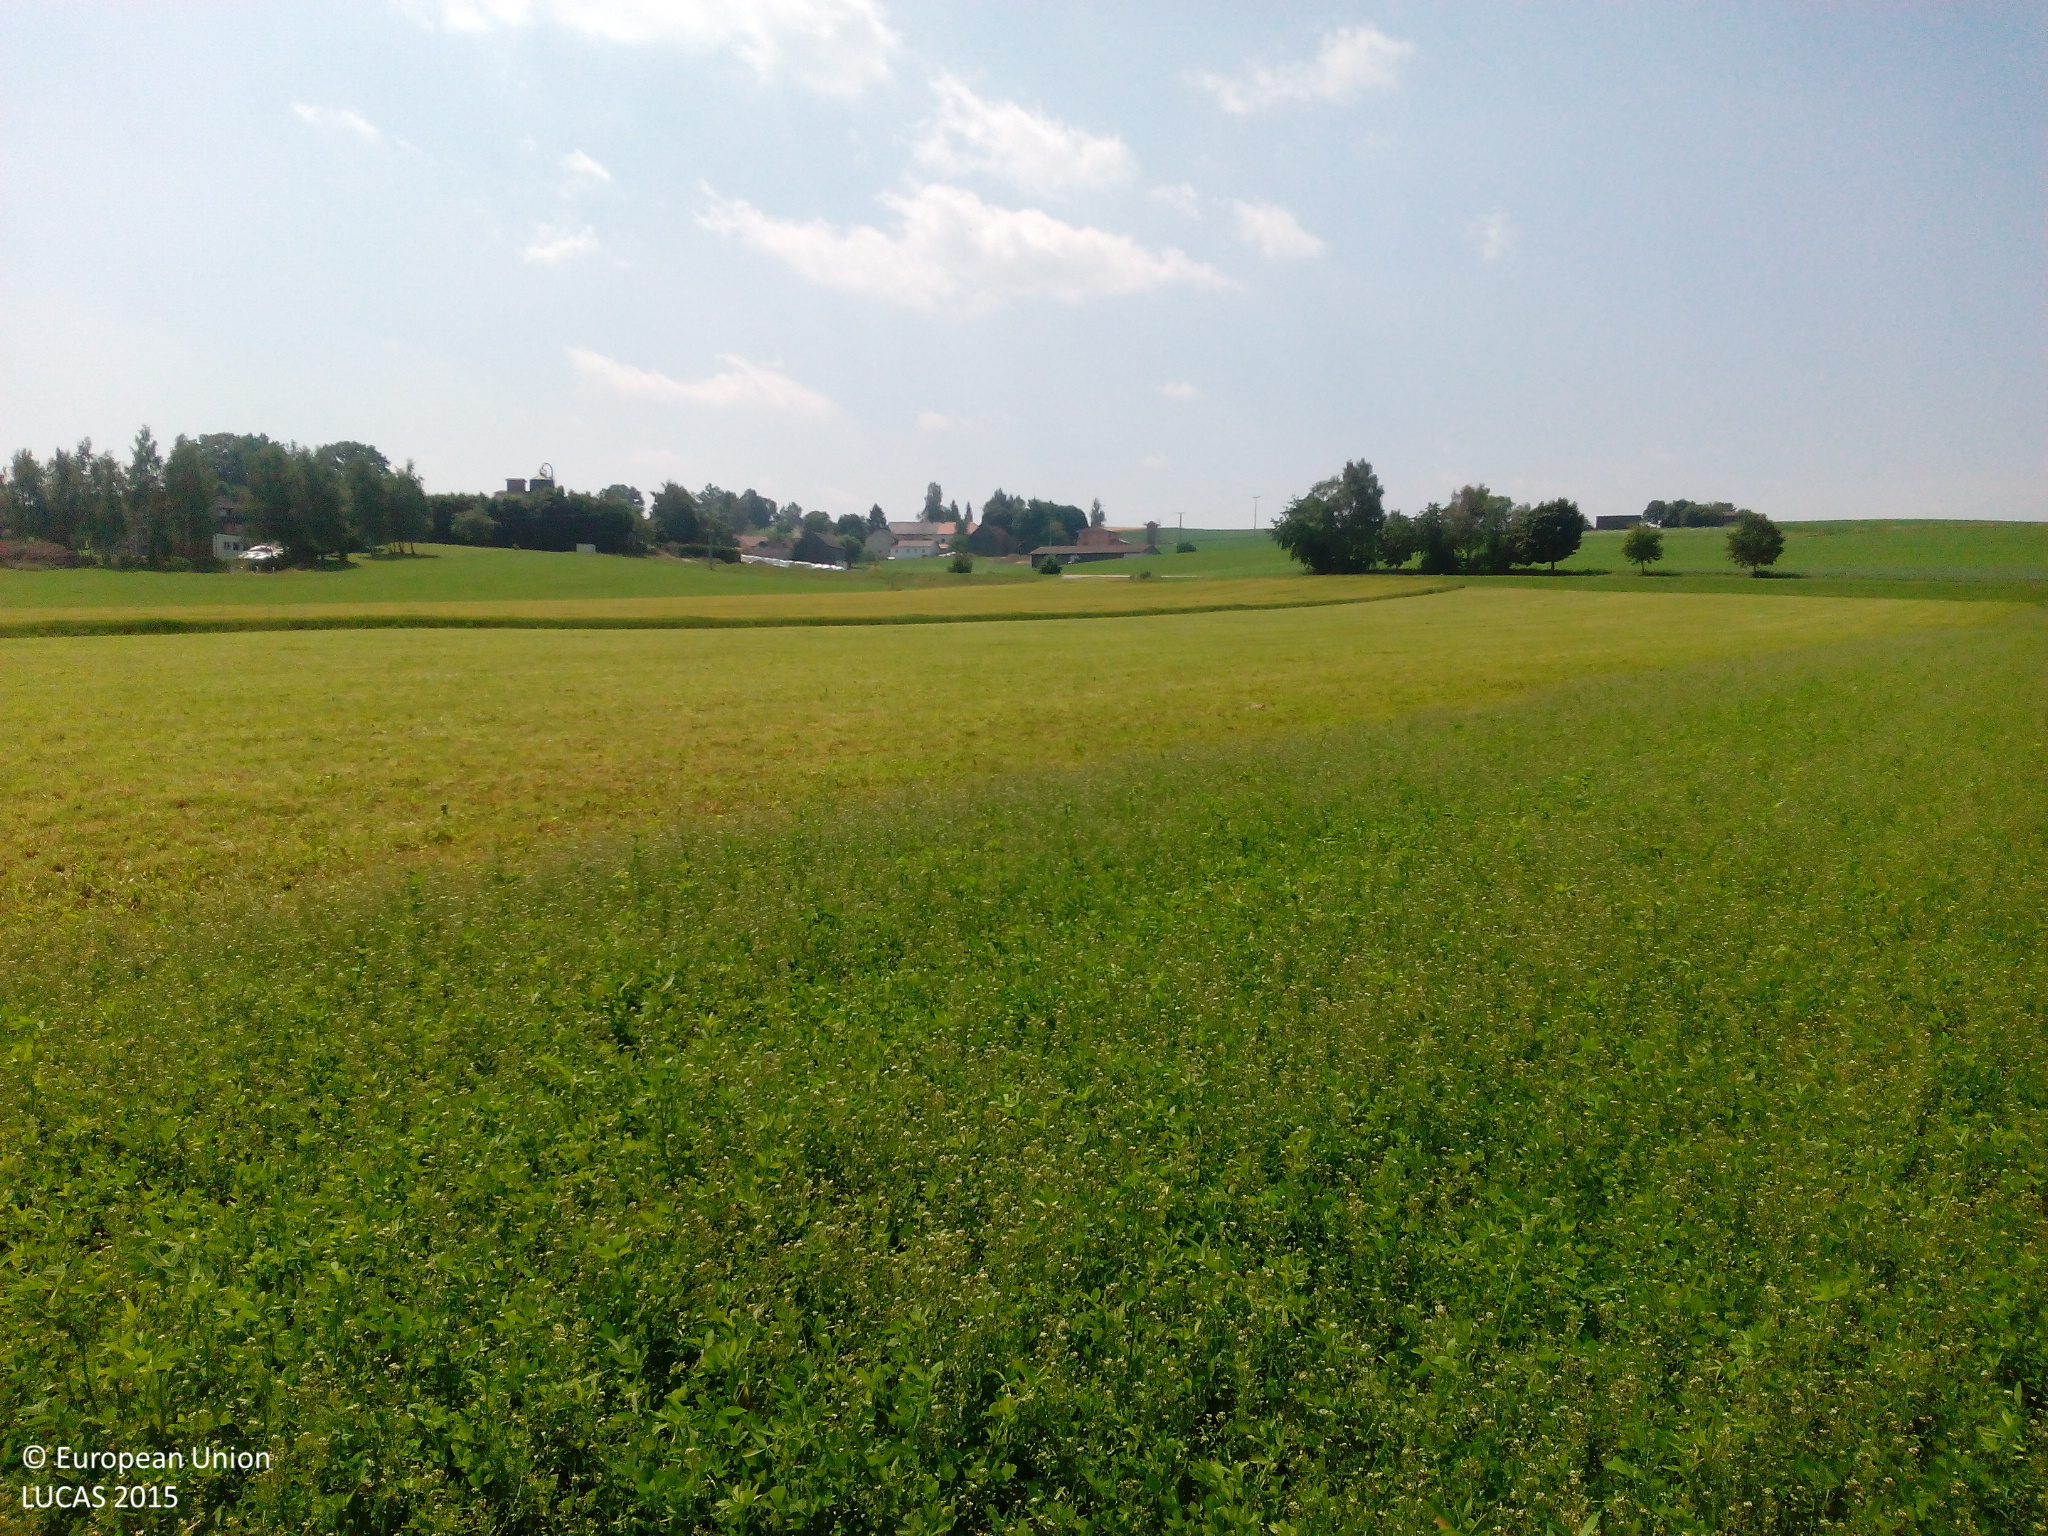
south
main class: Cropland
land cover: Other leguminous and mixtures for fodder
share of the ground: 50 - 75 %
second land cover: Lucerne
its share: 50 - 75 %
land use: Agriculture (excluding fallow land and kitchen gardens)
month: July
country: DE
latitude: 49.6002
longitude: 12.4486
